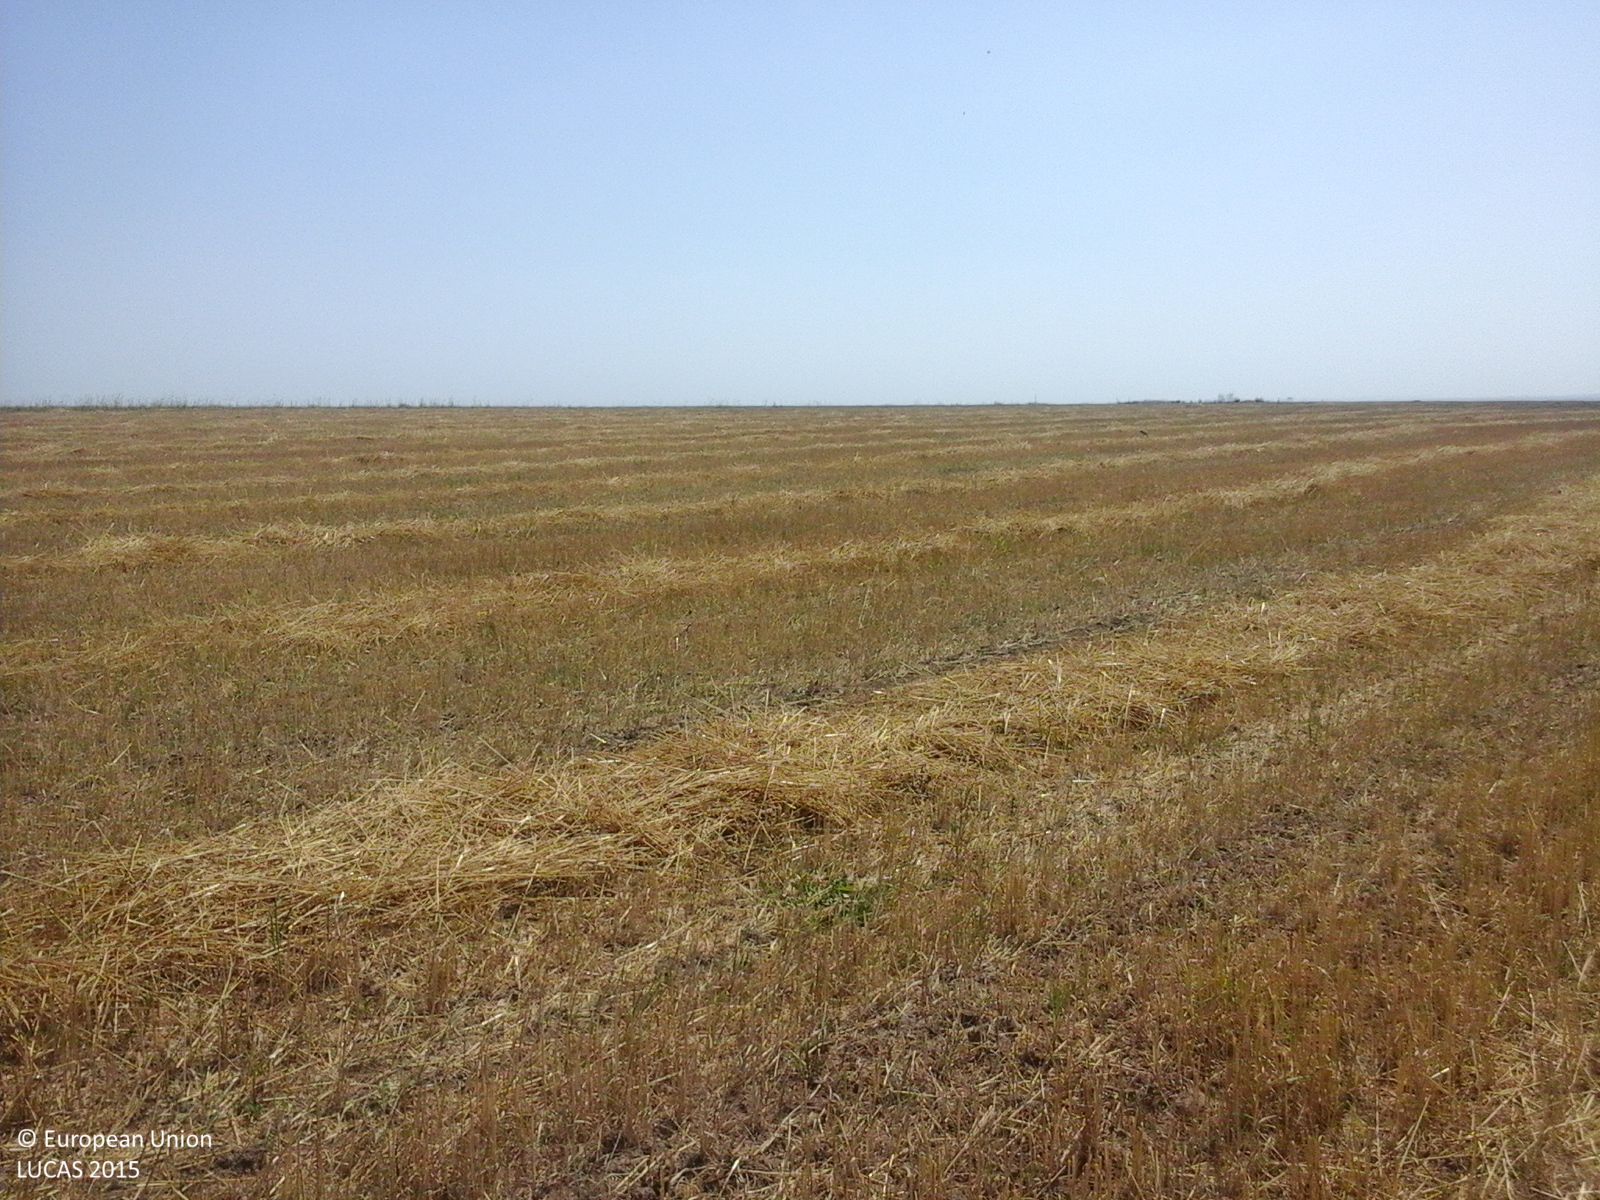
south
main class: Cropland
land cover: Common wheat
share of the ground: > 75 %
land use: Agriculture (excluding fallow land and kitchen gardens)
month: August
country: RO
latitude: 44.5288
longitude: 28.1181
